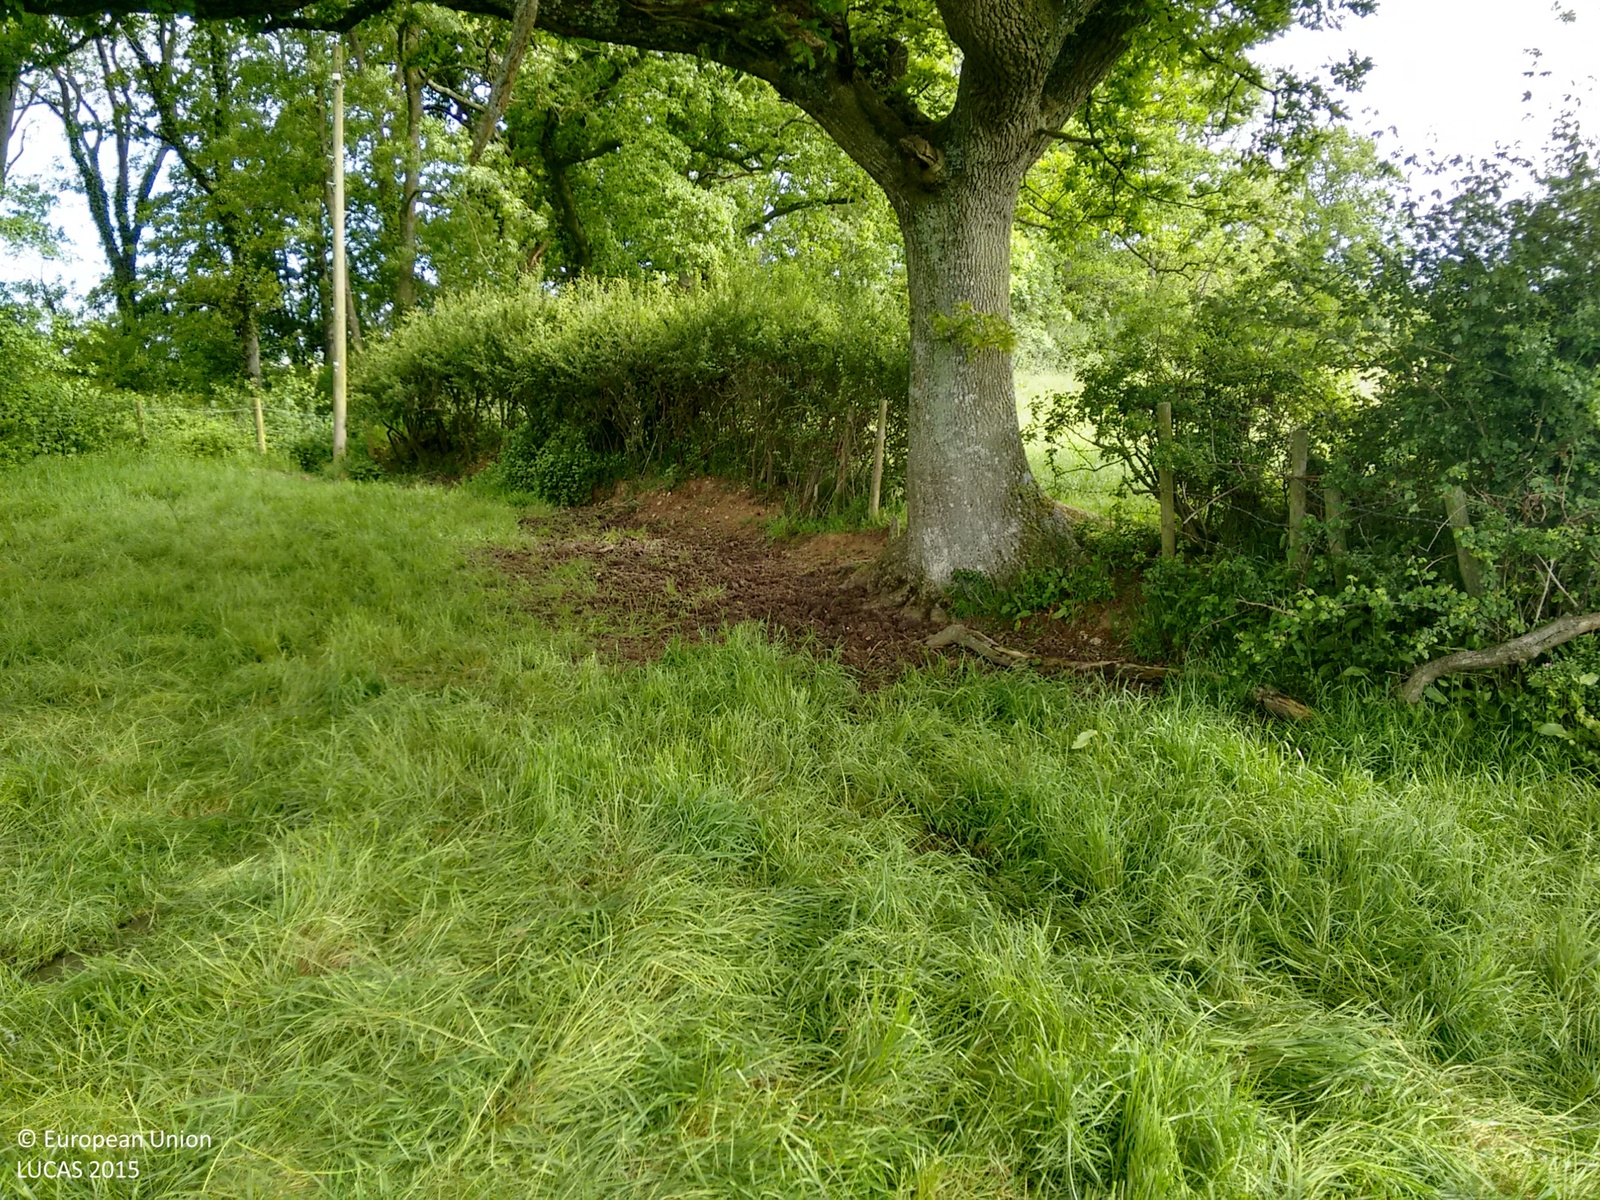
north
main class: Grassland
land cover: Grassland without tree/shrub cover
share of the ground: > 75 %
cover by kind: herbaceous plants 100 %
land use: Agriculture (excluding fallow land and kitchen gardens)
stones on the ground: < 10 %
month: June
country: GB
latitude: 51.0686
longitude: -2.2350
